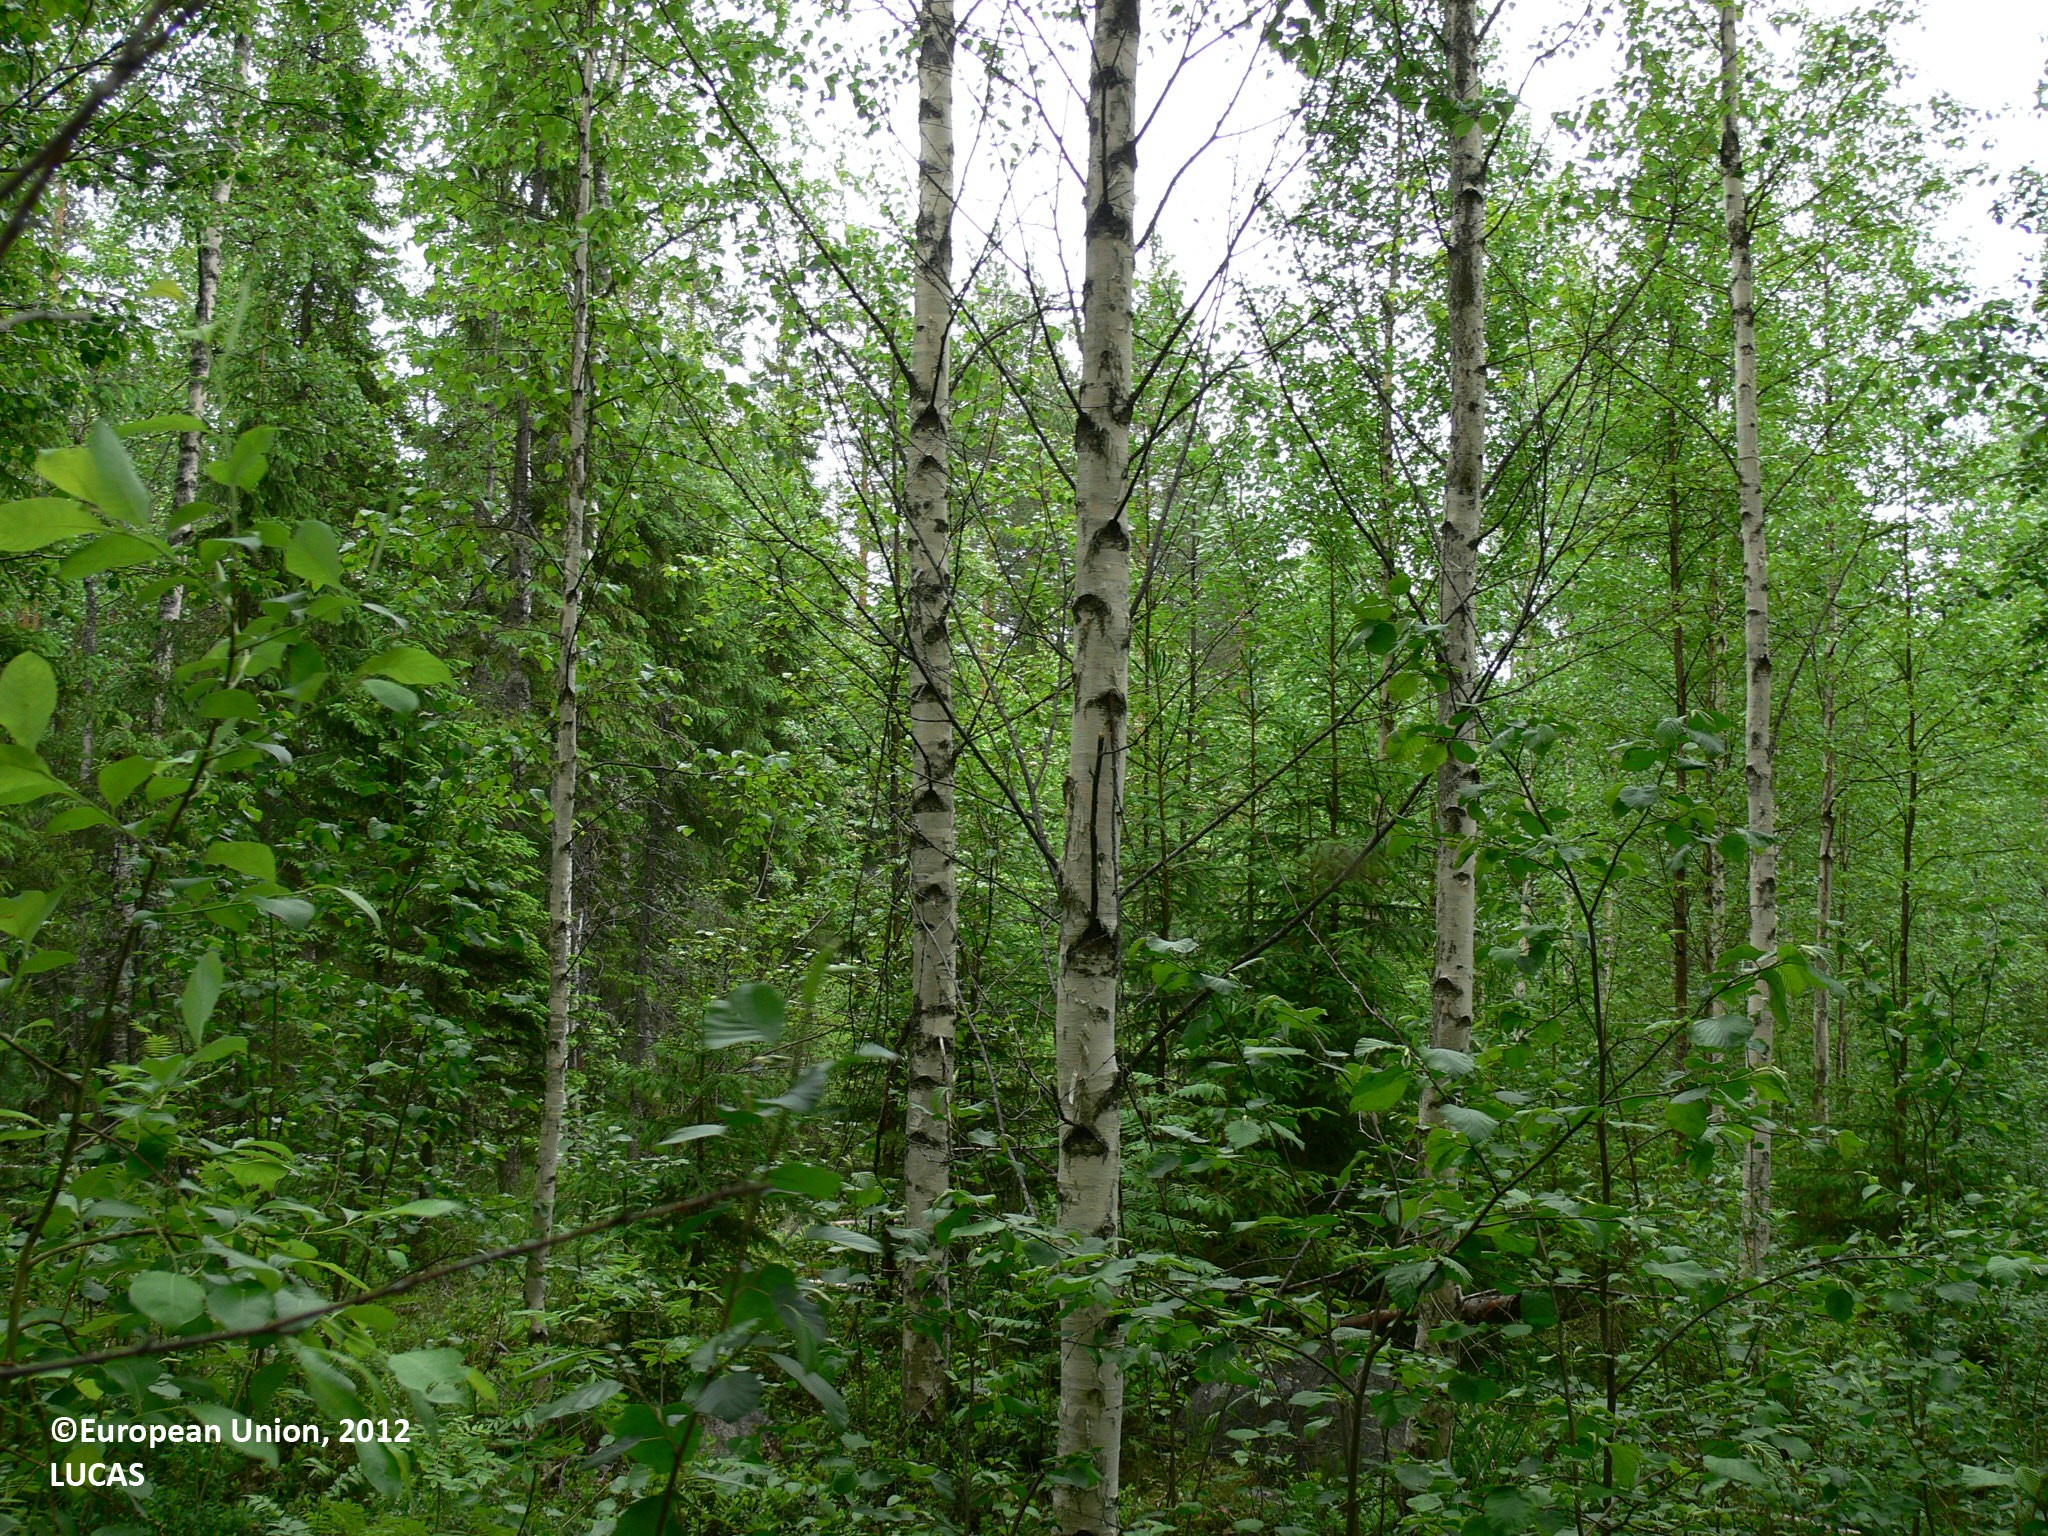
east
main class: Woodland
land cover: Broadleaved woodland
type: boreal forest
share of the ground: > 75 %
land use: Forestry
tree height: > 5 m
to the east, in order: Broadleaved woodland; Other mixed woodland; Other coniferous woodland; Other mixed woodland; Rocks and stones; Spruce dominated coniferous woodland; Other mixed woodland
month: June
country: FI
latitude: 62.7957
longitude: 30.4522
